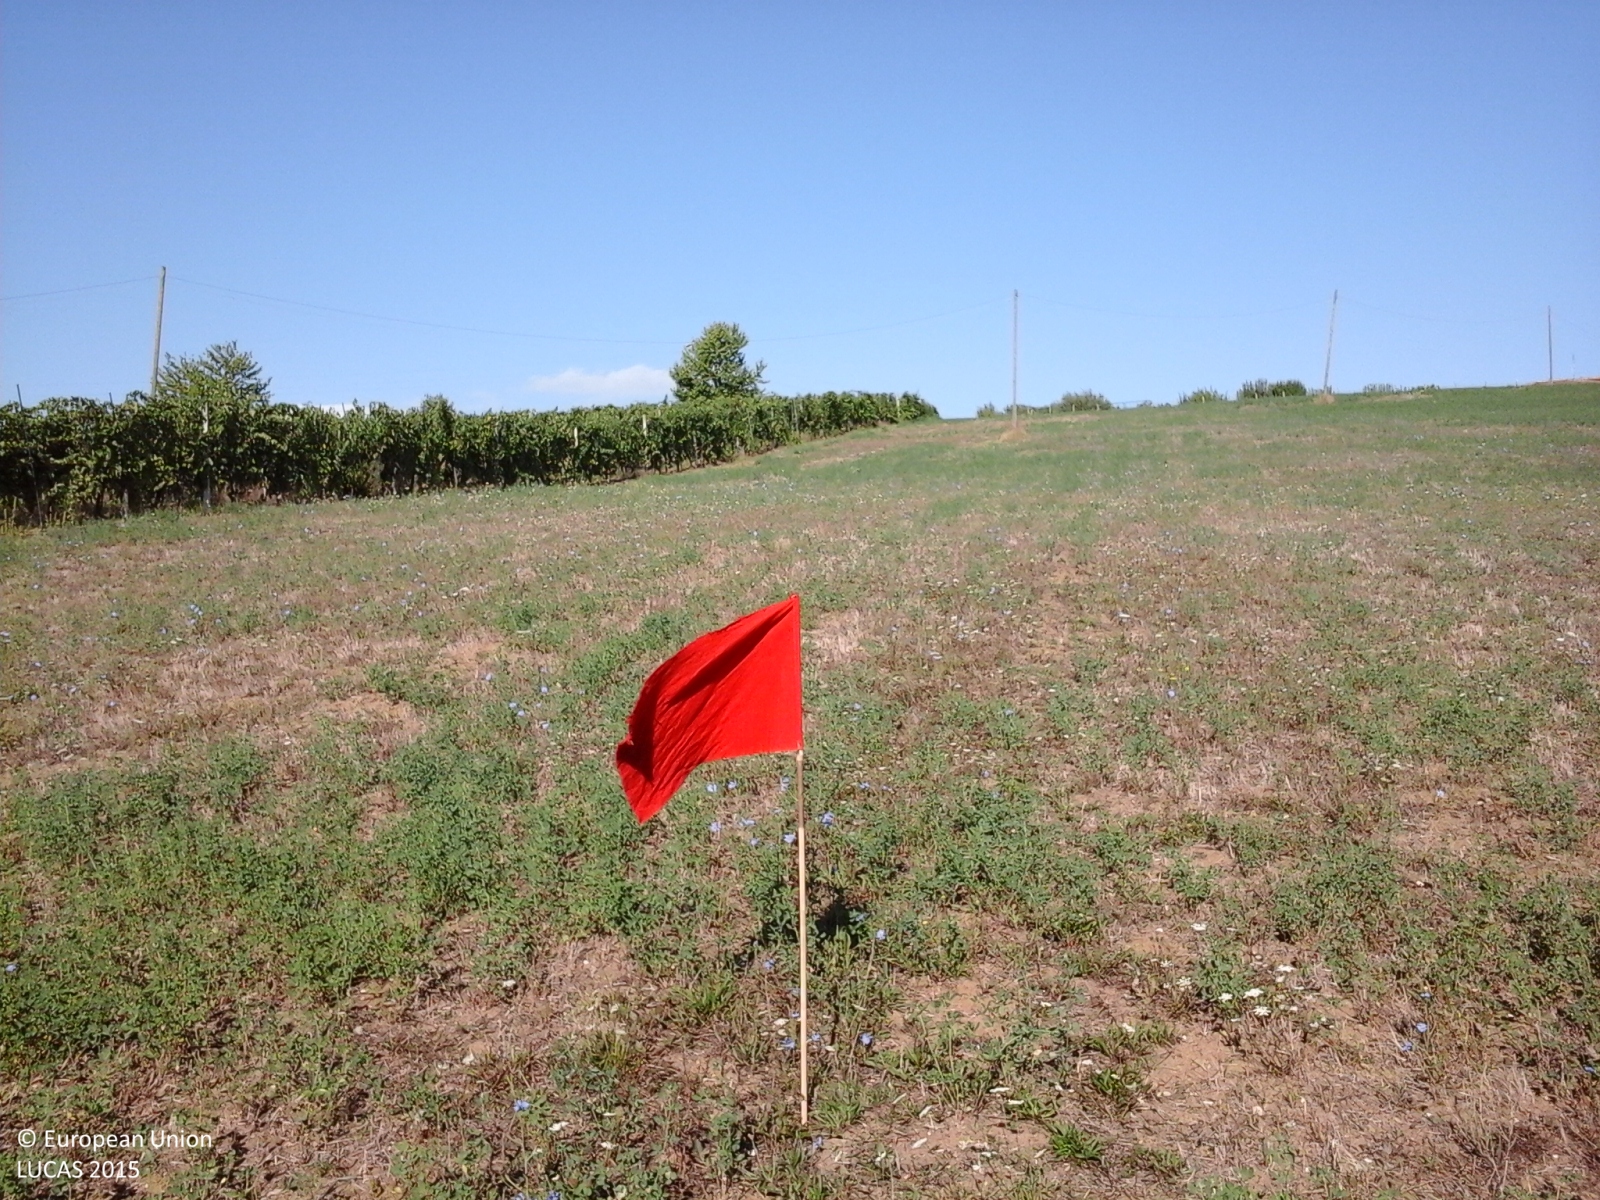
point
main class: Cropland
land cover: Clovers
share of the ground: > 75 %
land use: Agriculture (excluding fallow land and kitchen gardens)
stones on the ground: 10 - 25 %
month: September
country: IT
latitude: 43.2417
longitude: 13.0091
